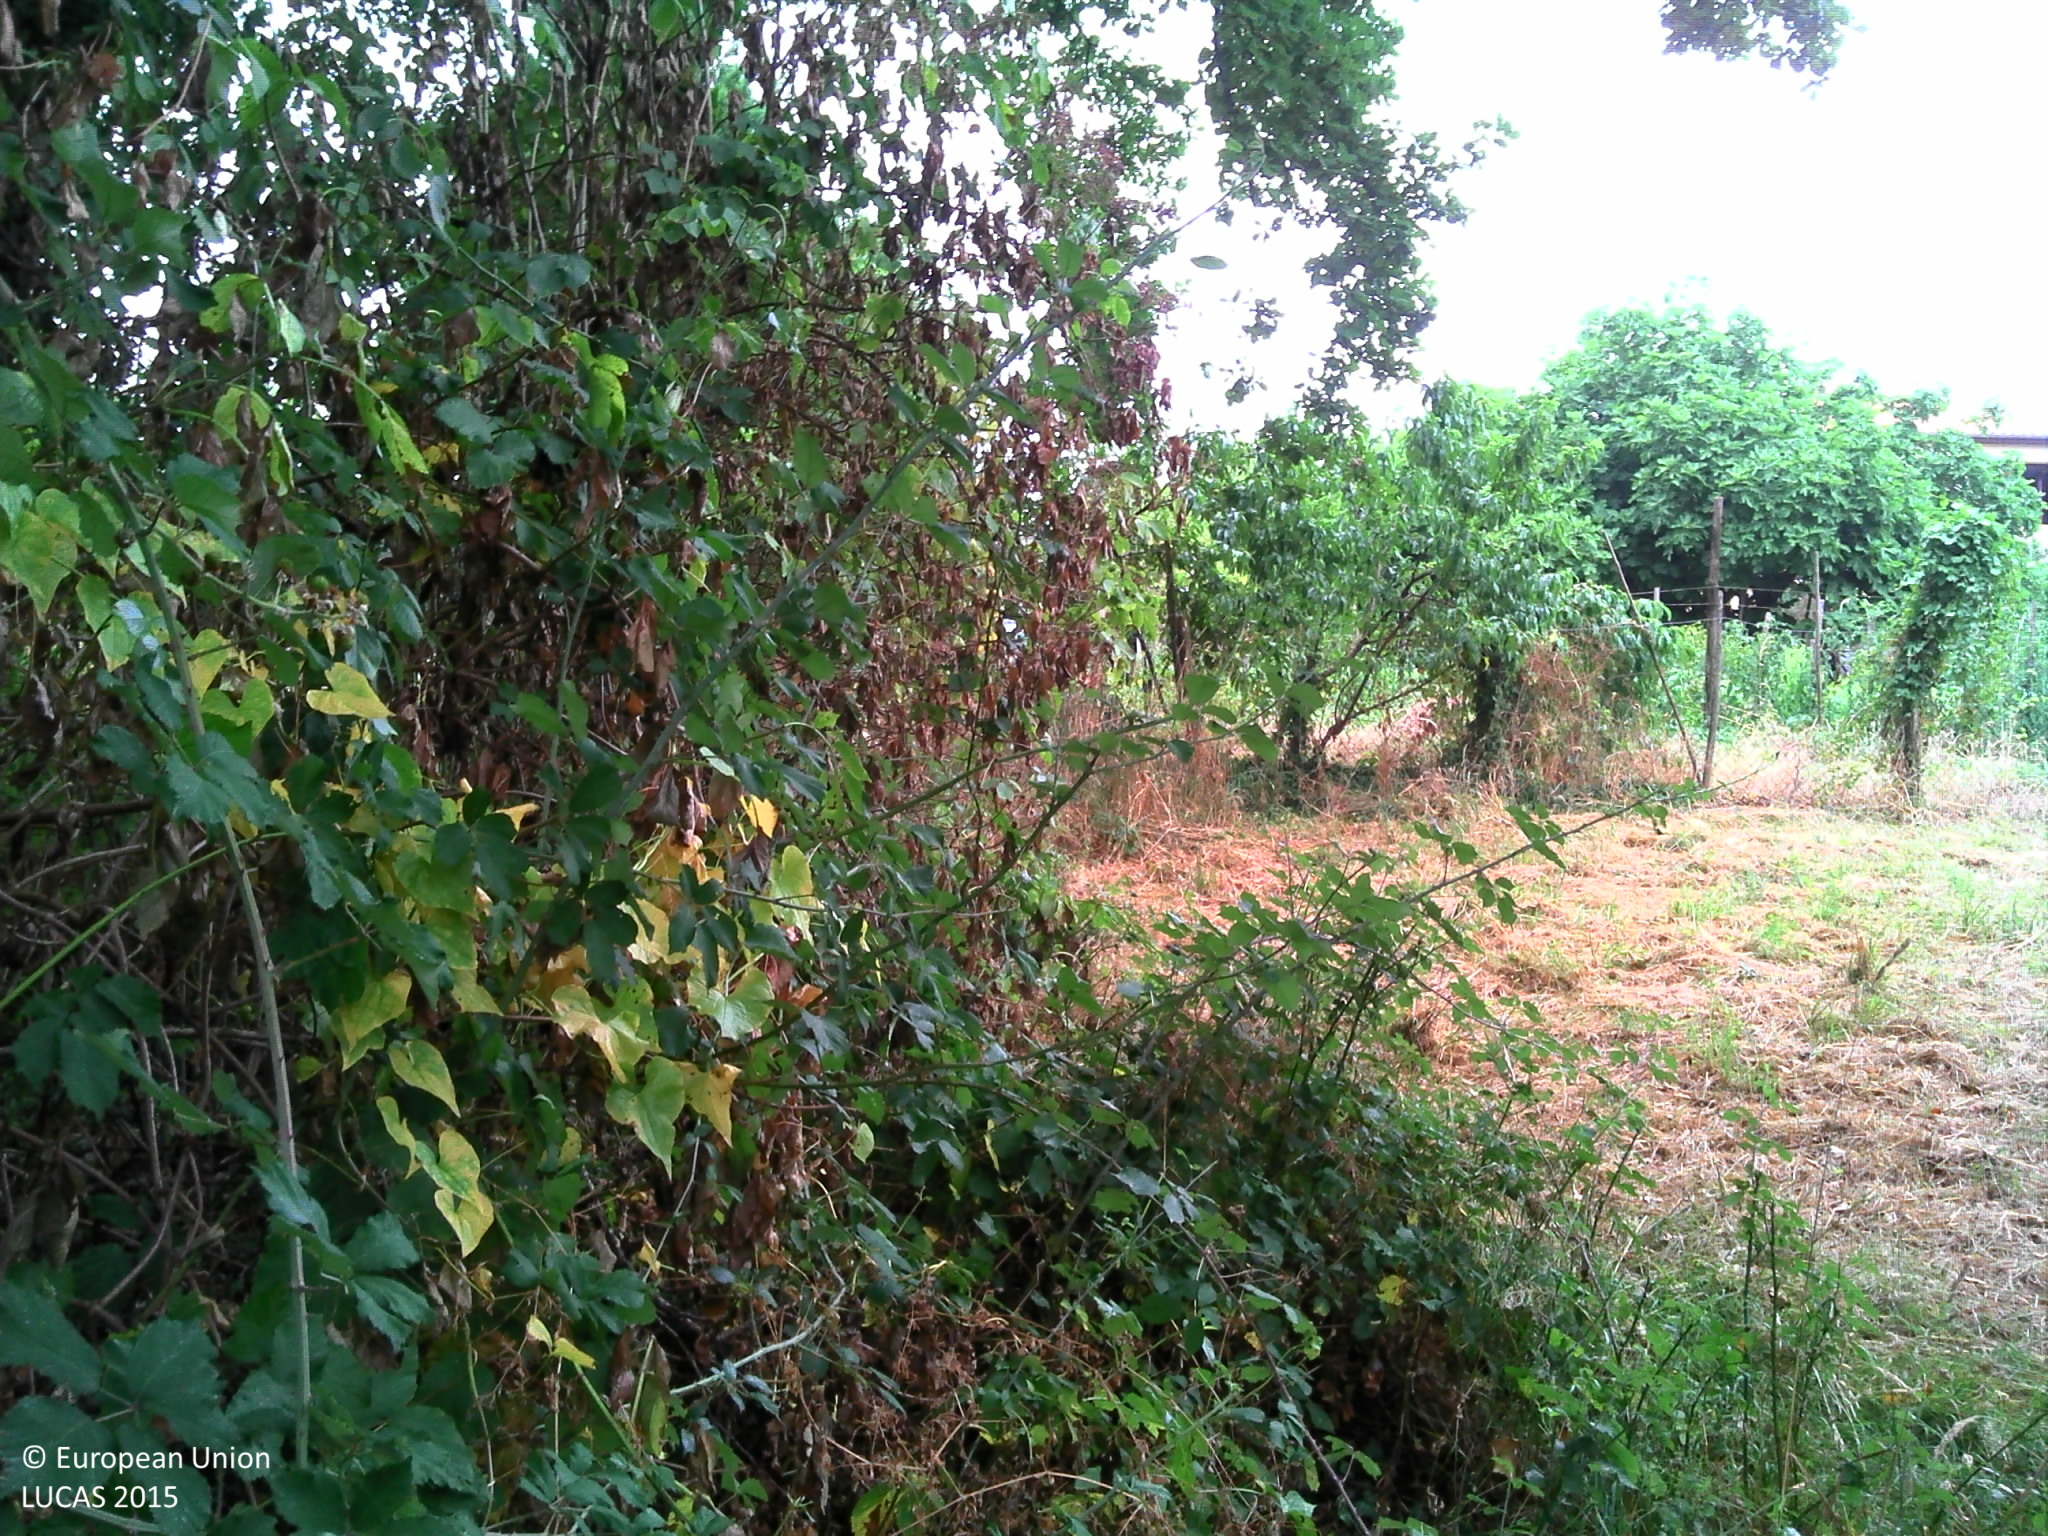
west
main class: Woodland
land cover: Broadleaved woodland
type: mesophytic deciduous forest
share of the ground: > 75 %
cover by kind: broadleaved forest trees 50 %, herbaceous plants 25 %, shrubs 20 %, lichens and mosses 5 %
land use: Forestry
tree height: > 5 m
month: July
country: FR
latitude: 44.9121
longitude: 0.5028
